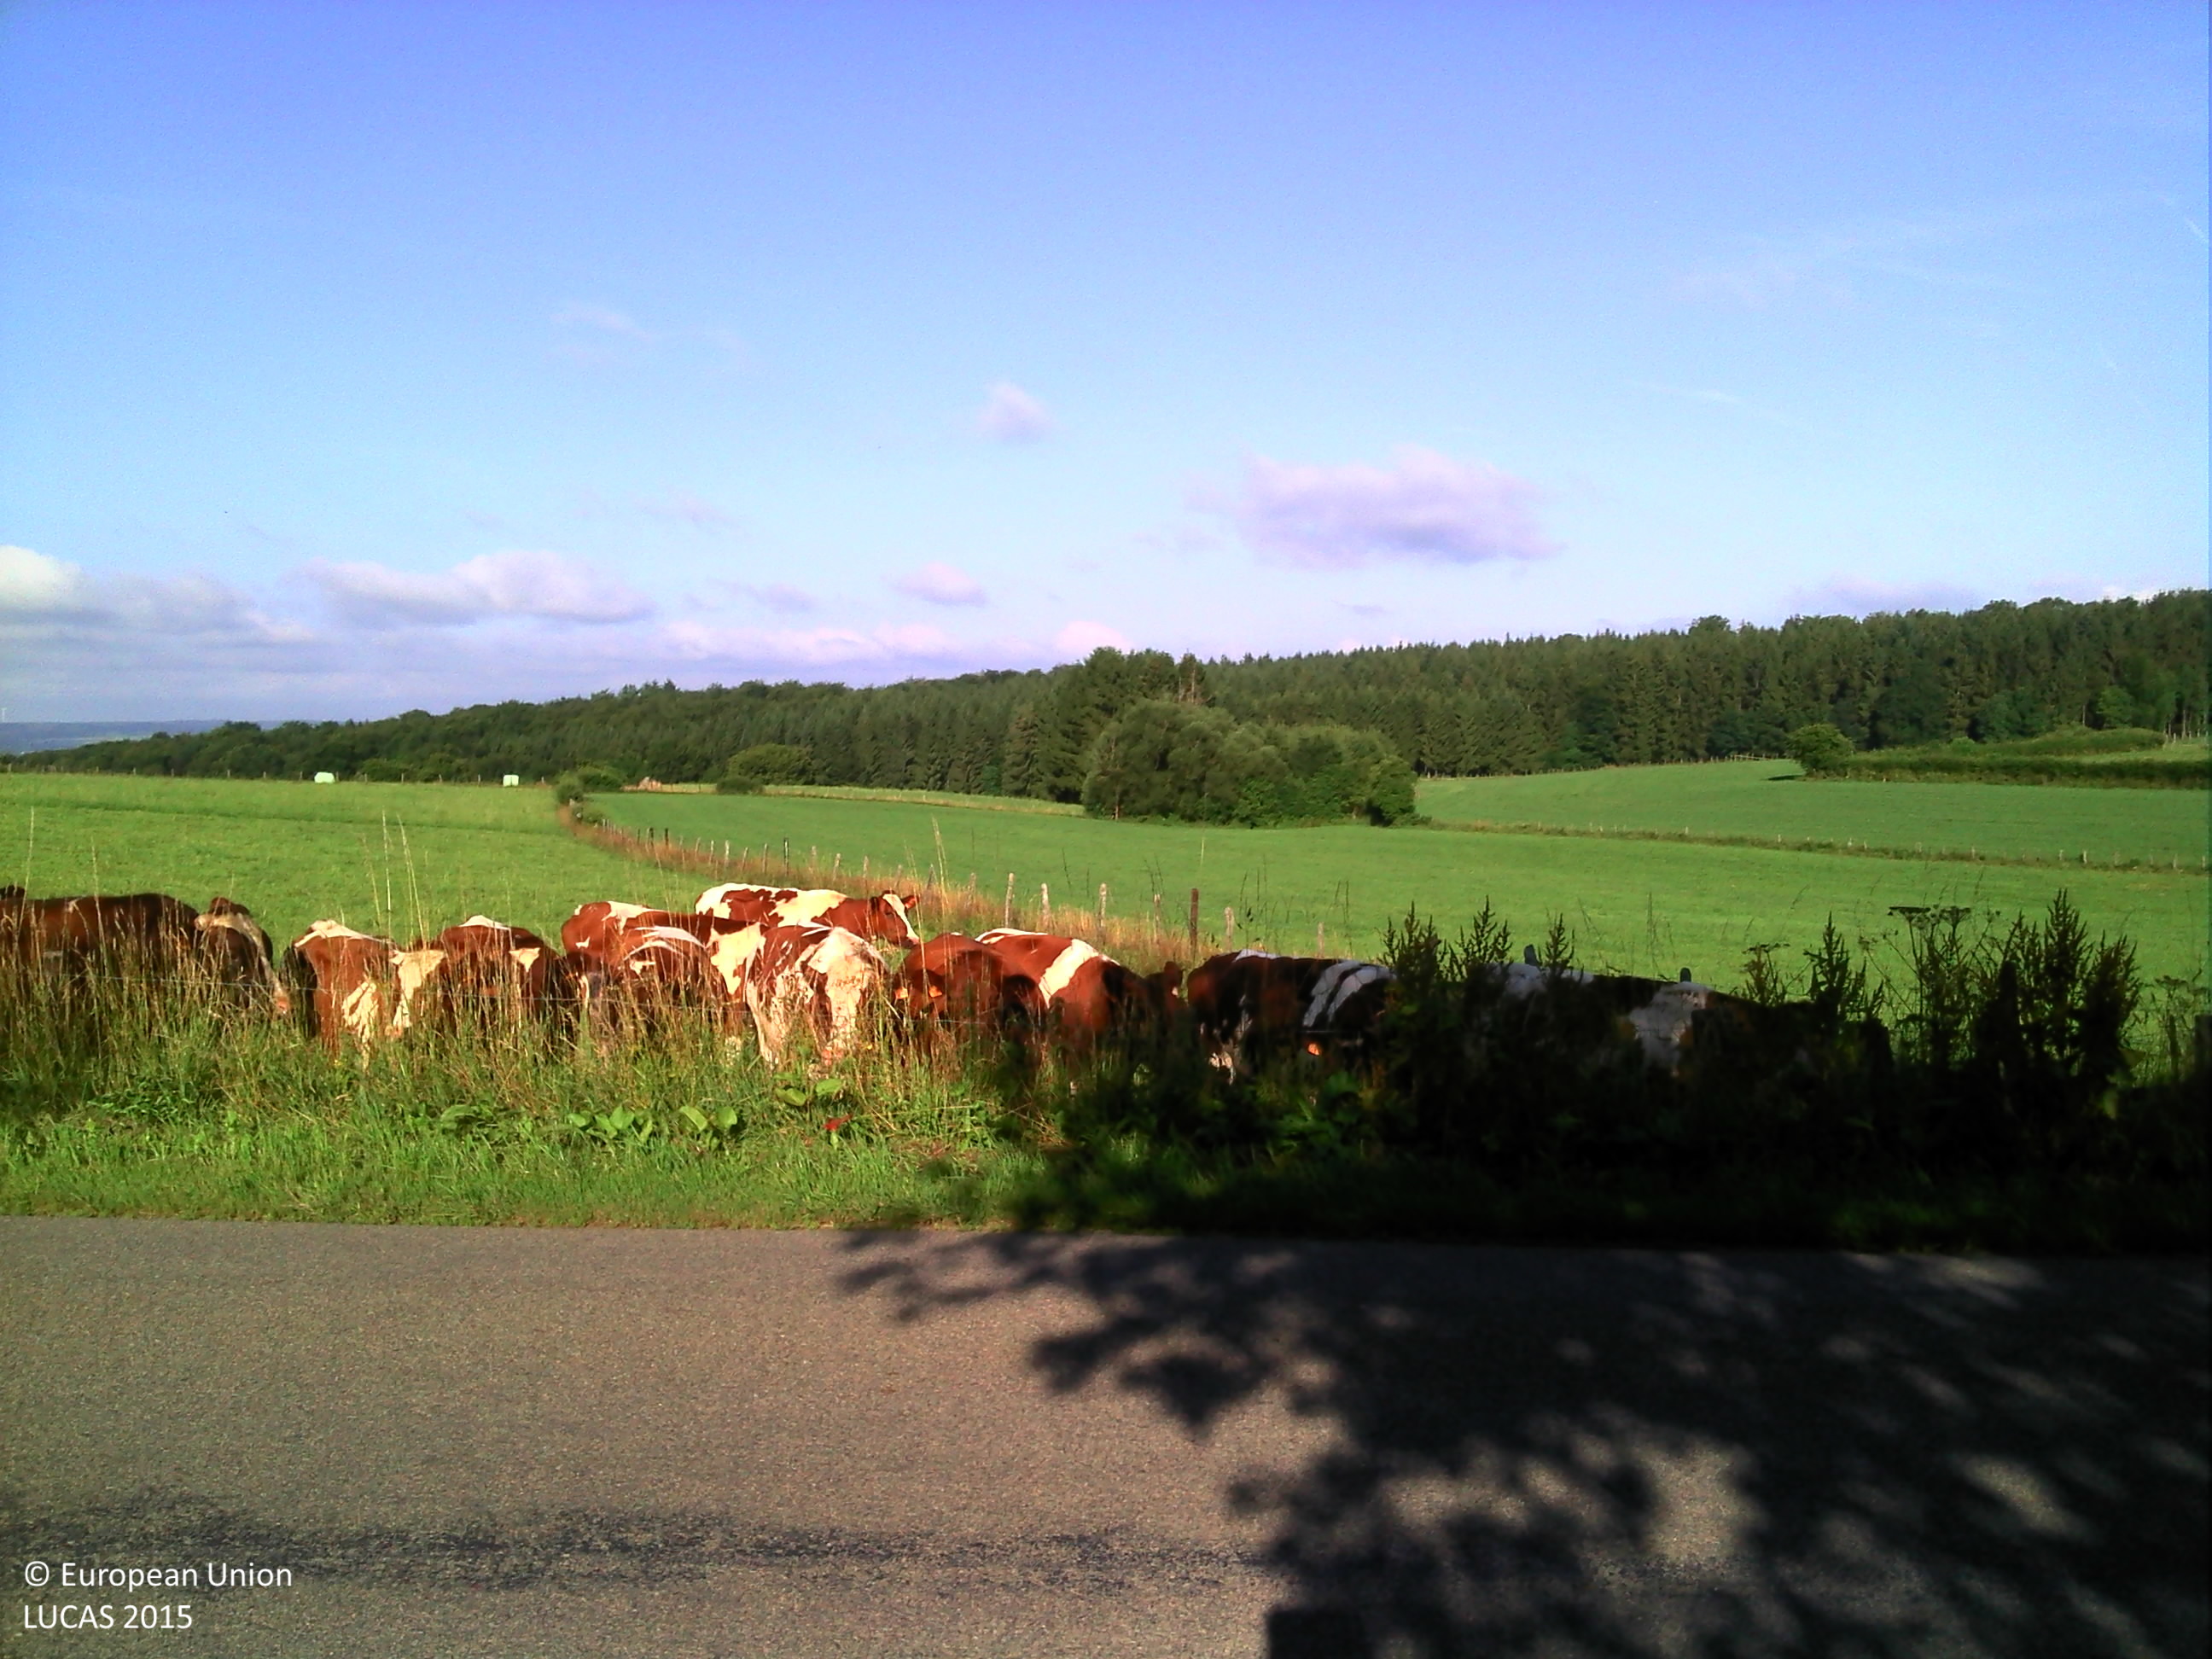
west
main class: Grassland
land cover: Grassland without tree/shrub cover
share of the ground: > 75 %
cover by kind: herbaceous plants 100 %
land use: Agriculture (excluding fallow land and kitchen gardens)
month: July
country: BE
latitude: 50.3735
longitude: 6.2170
